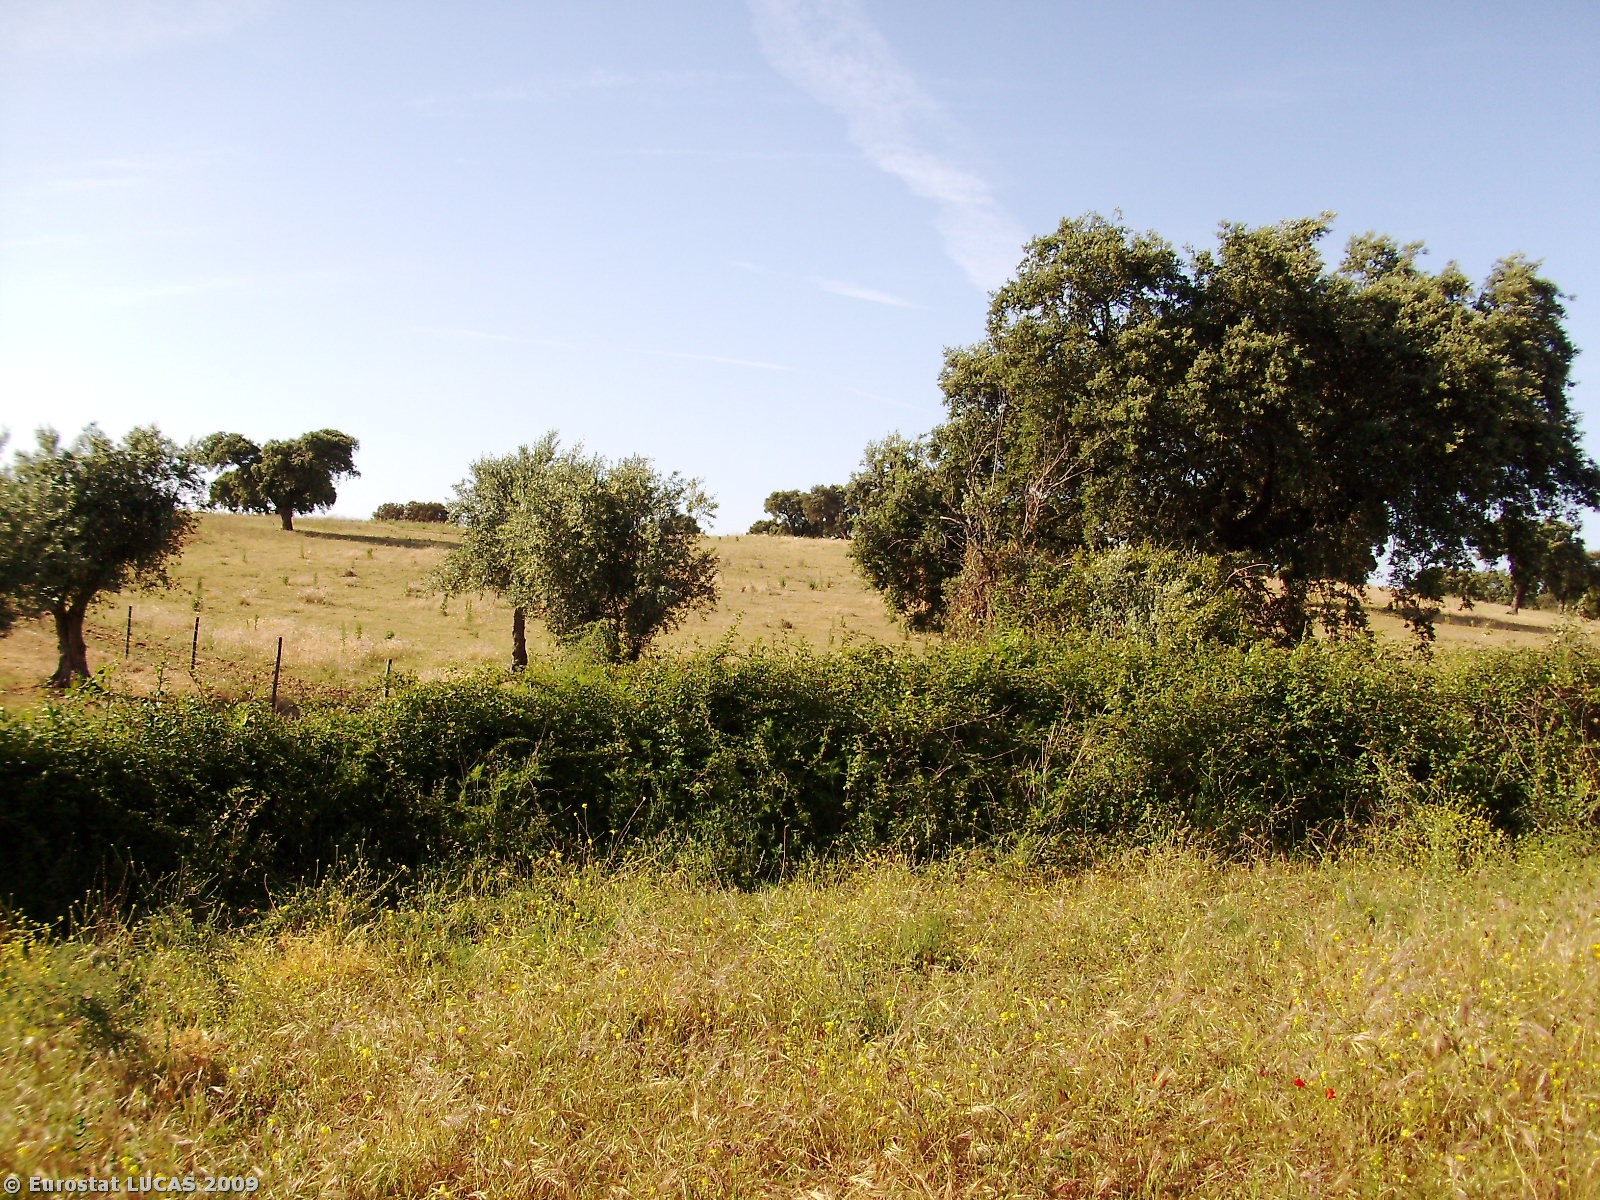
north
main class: Cropland
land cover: Olive groves
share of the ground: 10 - 25 %
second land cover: Grassland with sparse tree/shrub cover
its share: > 75 %
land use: Agriculture (excluding fallow land and kitchen gardens)
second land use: Fallow land
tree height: > 5 m
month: May
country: PT
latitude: 39.0705
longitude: -7.7877
